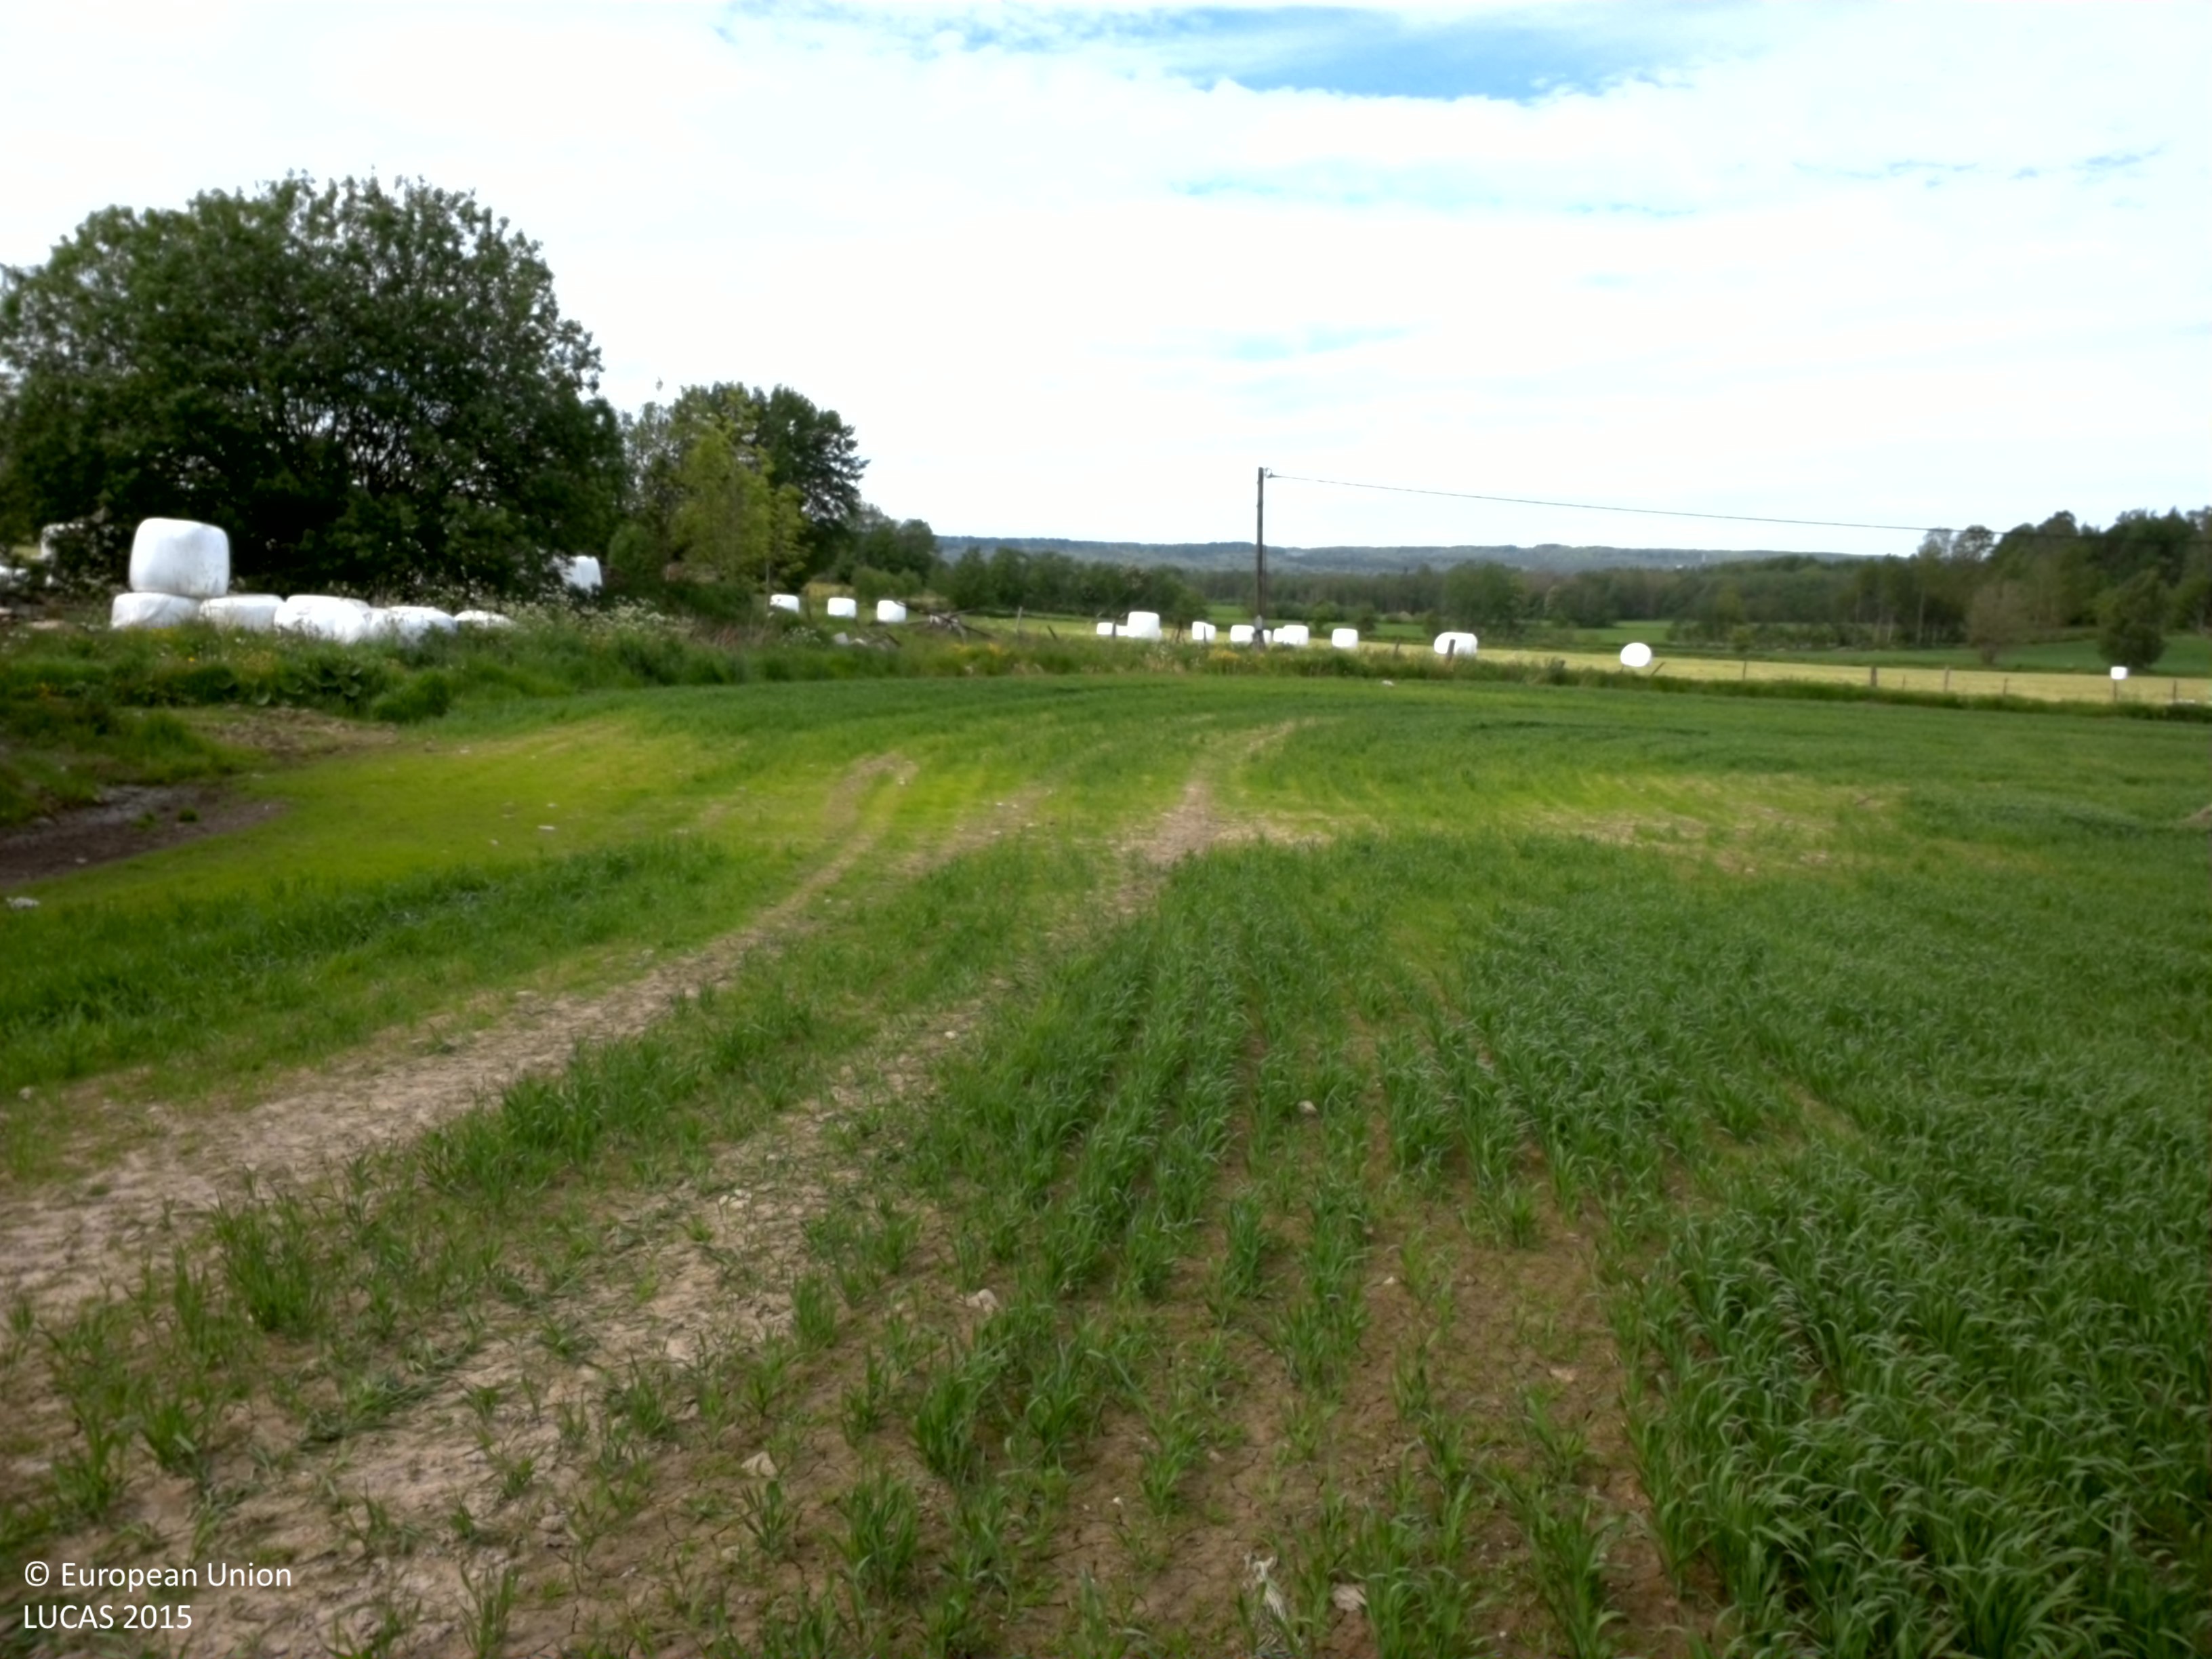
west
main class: Cropland
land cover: Oats
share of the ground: > 75 %
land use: Agriculture (excluding fallow land and kitchen gardens)
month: June
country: SE
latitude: 58.4147
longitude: 13.9137
